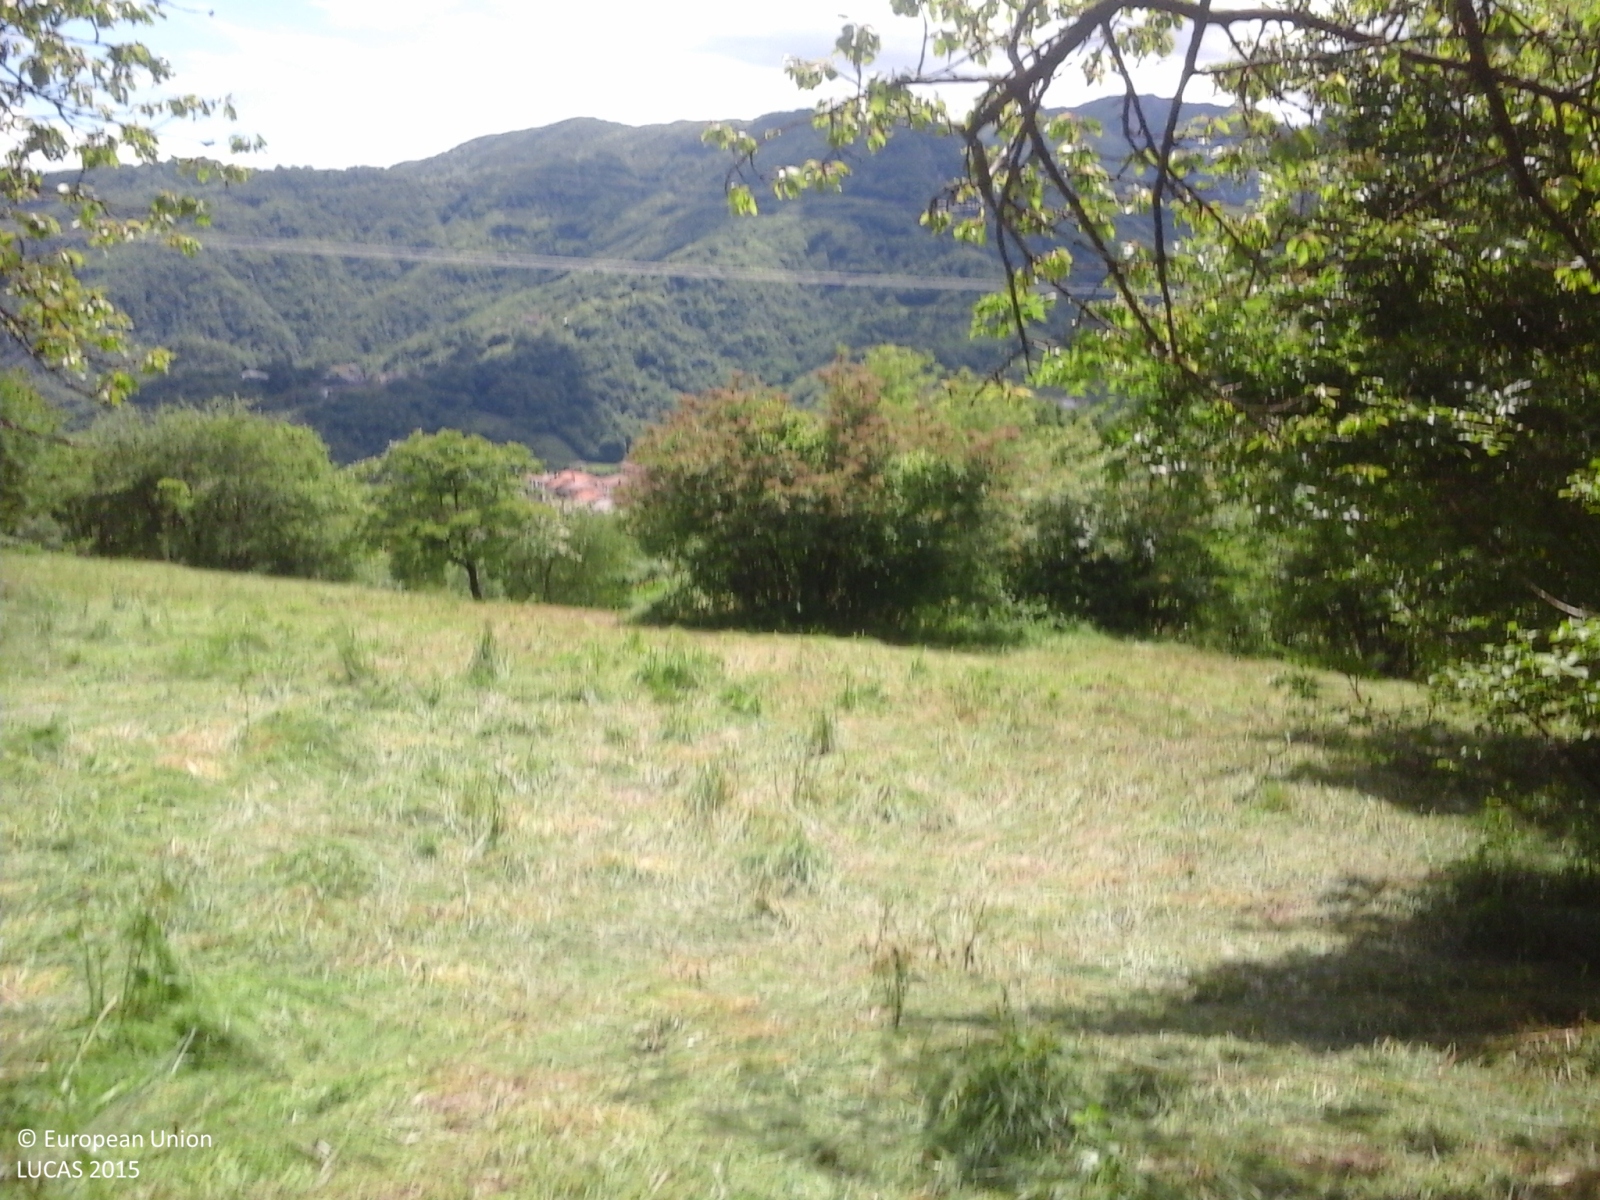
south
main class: Cropland
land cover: Cherry fruit
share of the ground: 25 - 50 %
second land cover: Grassland without tree/shrub cover
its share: > 75 %
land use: Agriculture (excluding fallow land and kitchen gardens)
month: May
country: IT
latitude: 45.7133
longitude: 11.2441
